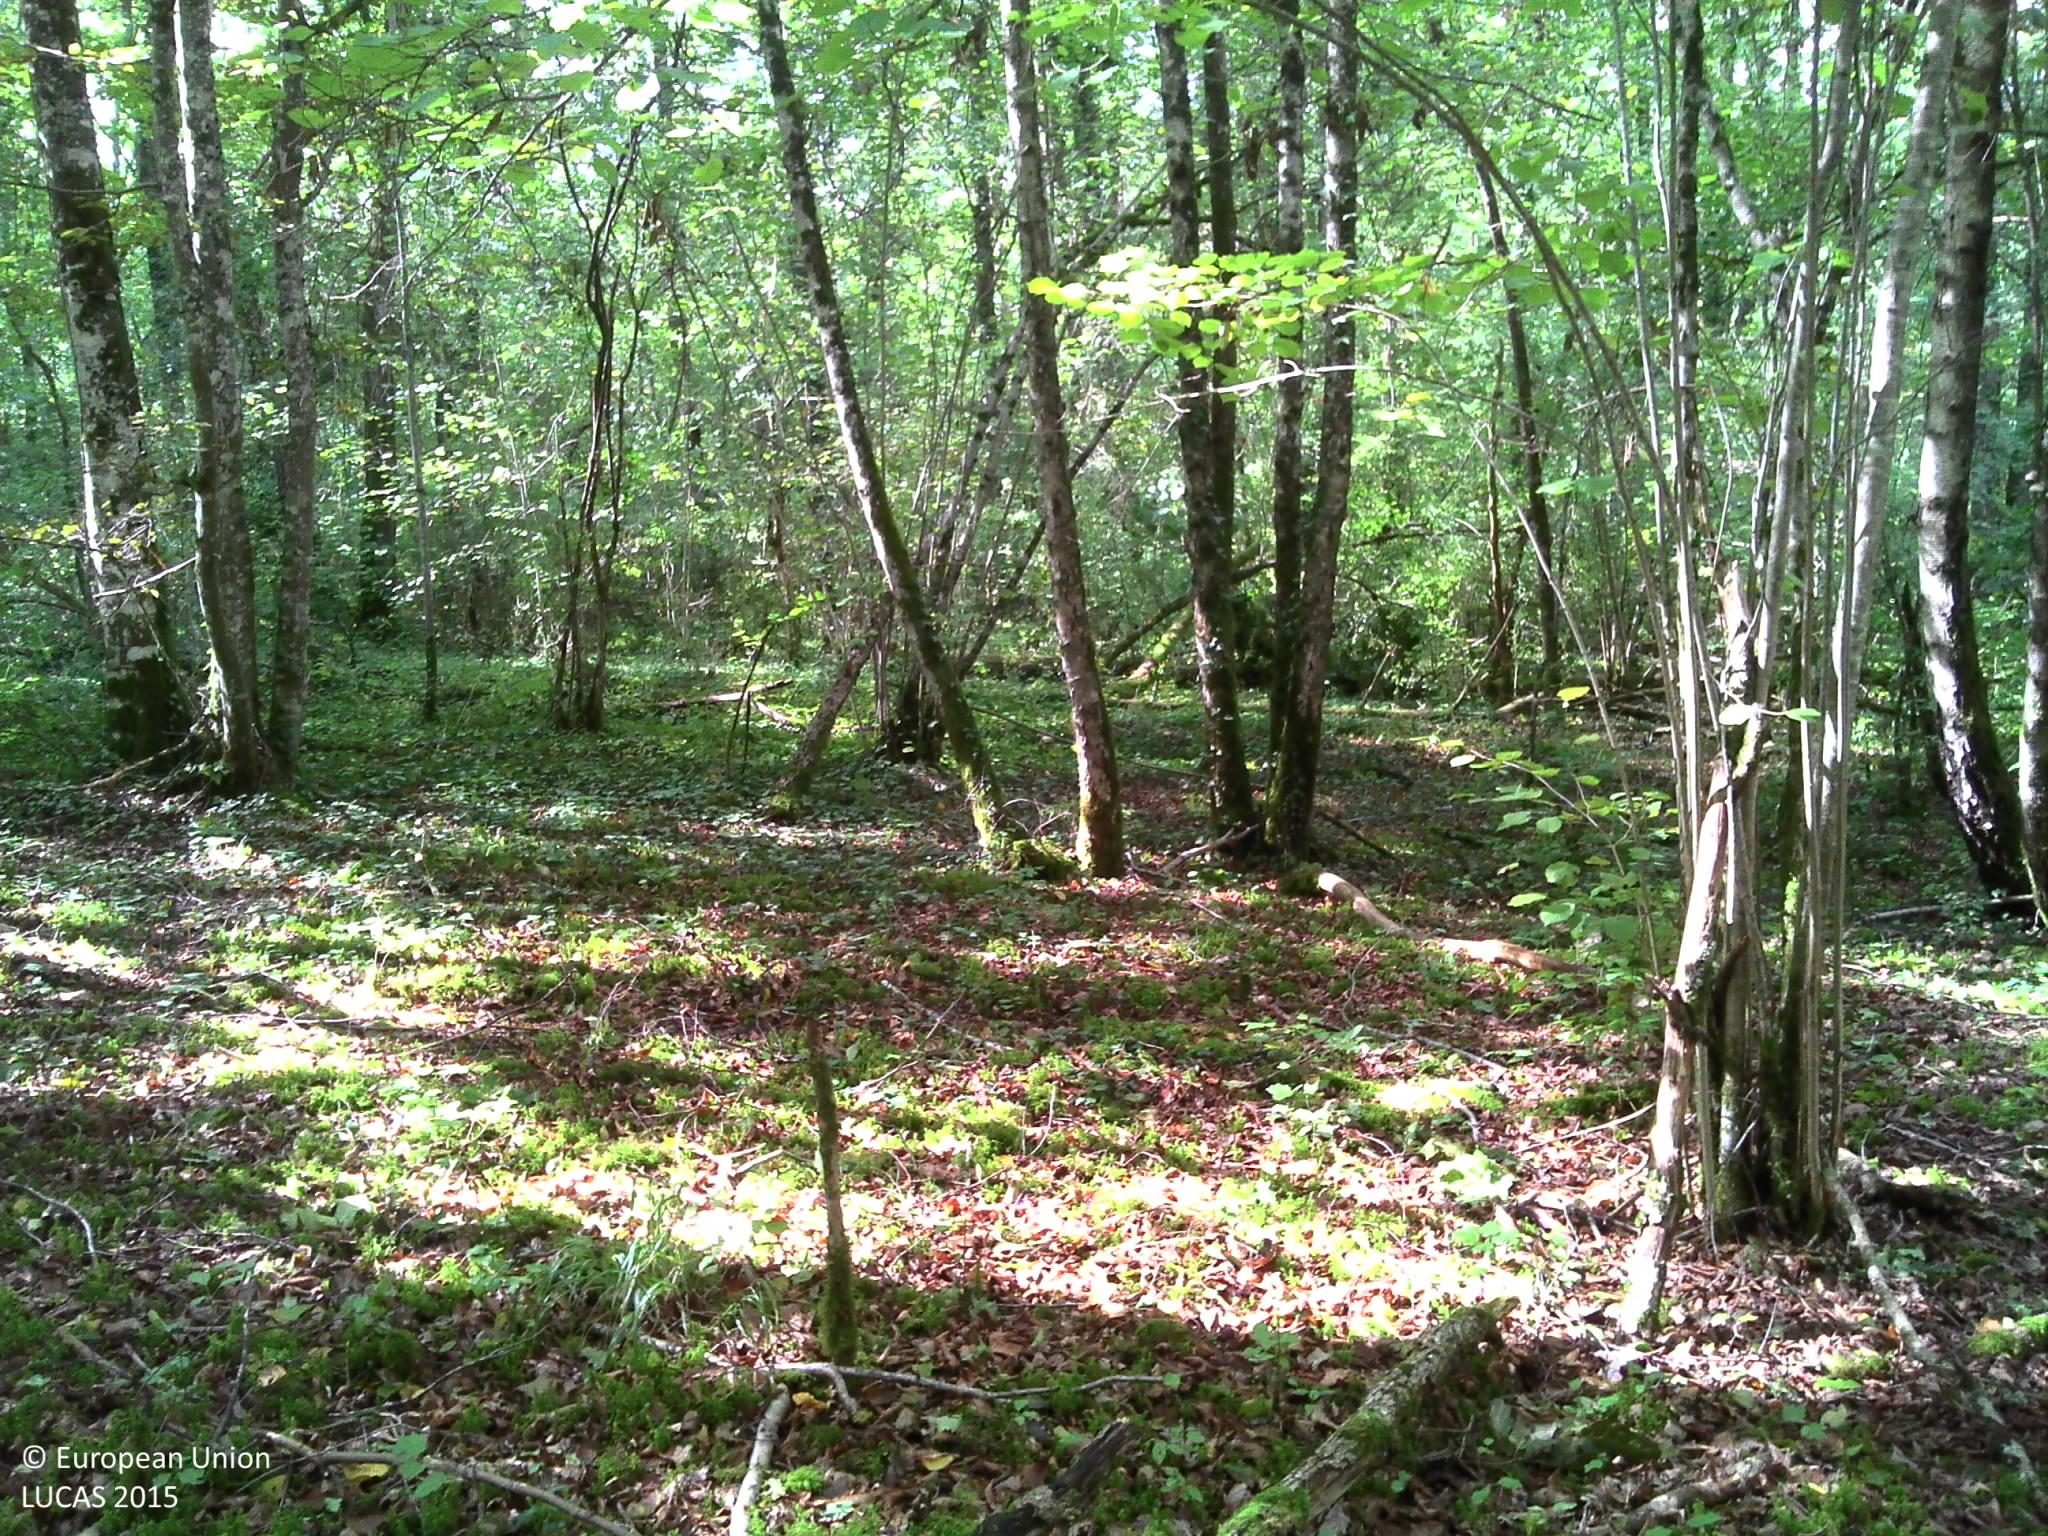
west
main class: Woodland
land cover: Broadleaved woodland
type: mesophytic deciduous forest
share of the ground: > 75 %
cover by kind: broadleaved forest trees 90 %, herbaceous plants 5 %, lichens and mosses 5 %
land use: Forestry
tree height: > 5 m
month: September
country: FR
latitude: 48.0205
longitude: 4.2723
